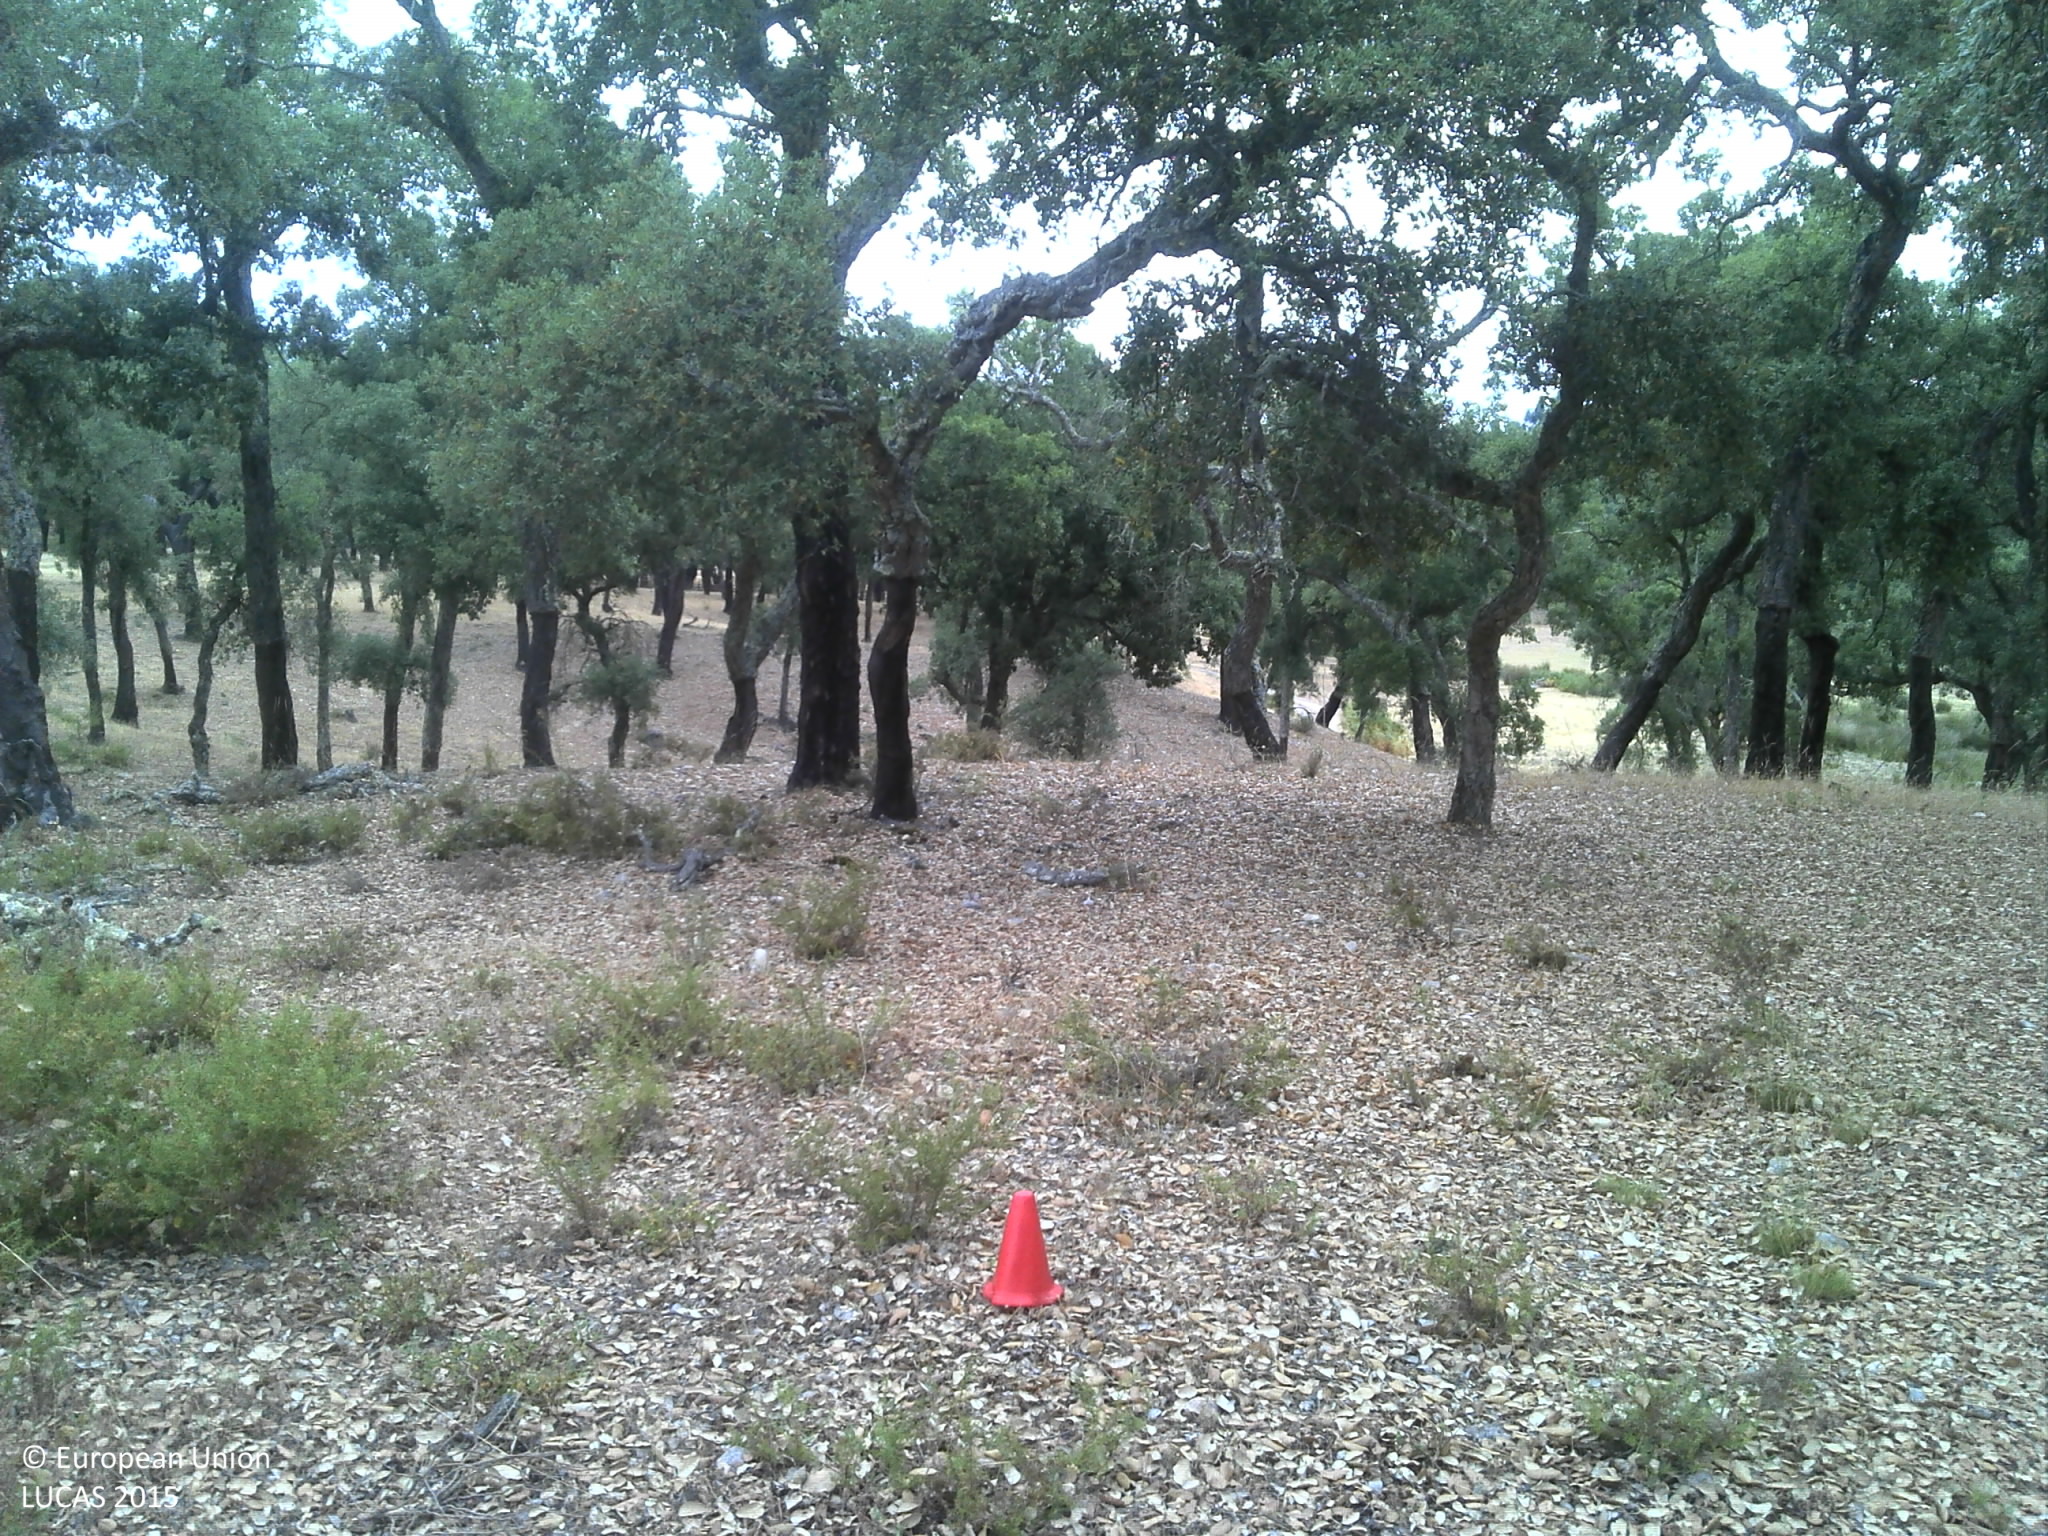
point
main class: Woodland
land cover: Broadleaved woodland
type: broadleaved evergreen forest
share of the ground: 25 - 50 %
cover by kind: broadleaved forest trees 50 %, unconsolidated bare surface 35 %, shrubs 10 %, herbaceous plants 5 %
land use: Forestry
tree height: > 5 m
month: June
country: PT
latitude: 39.3218
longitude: -8.0240
